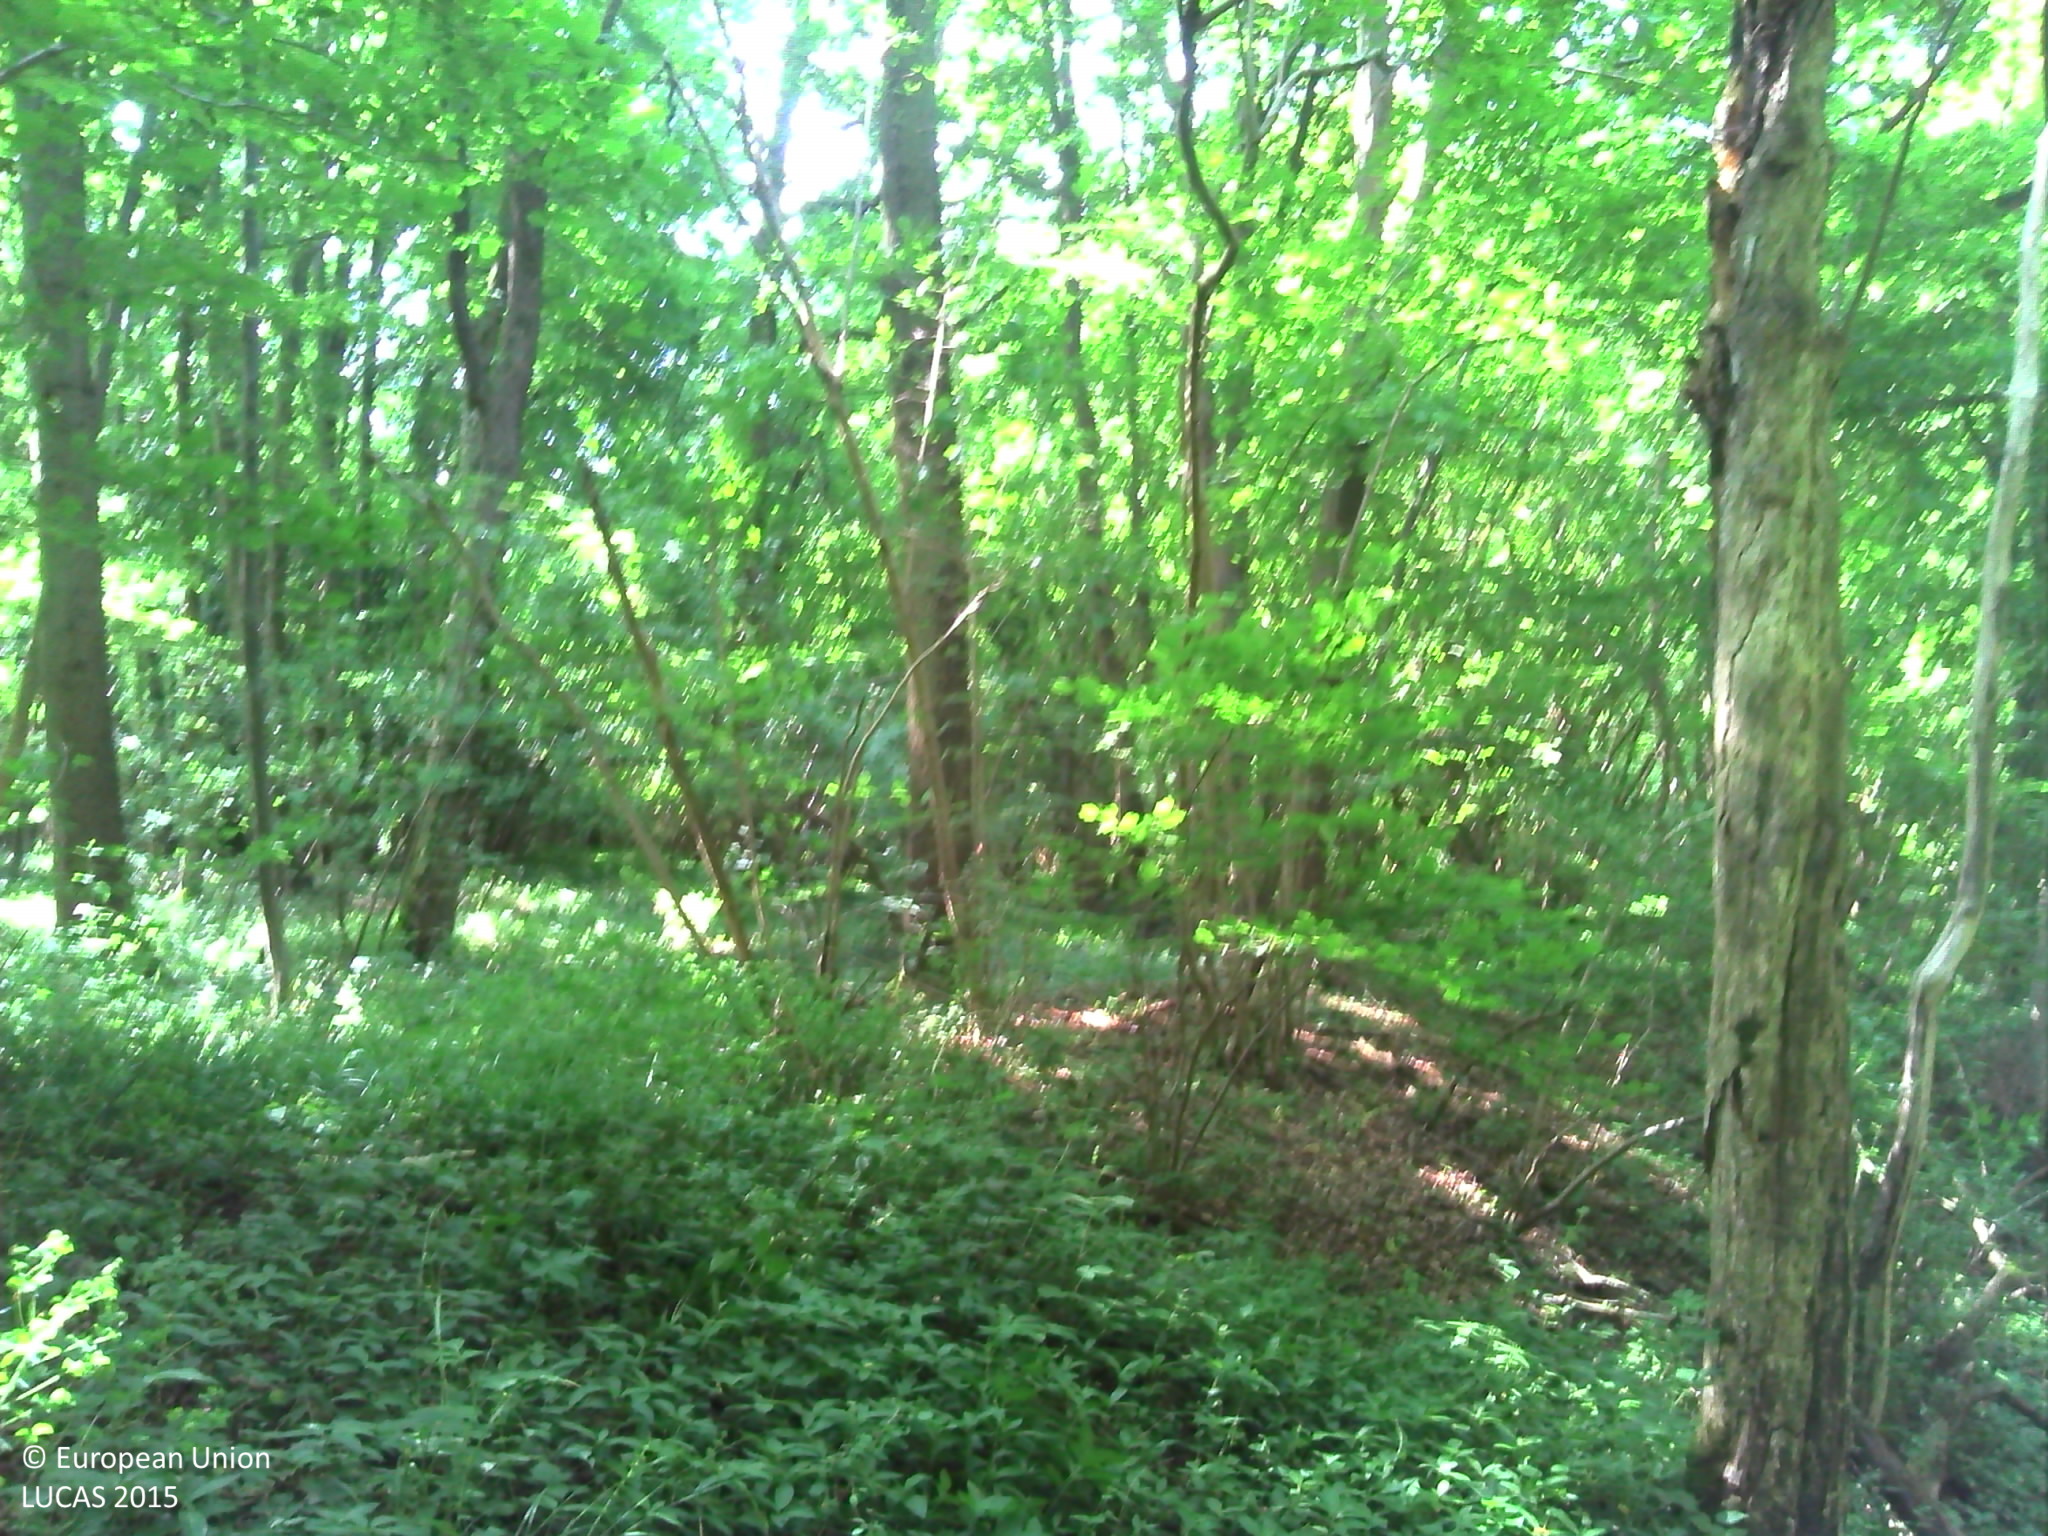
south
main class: Woodland
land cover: Broadleaved woodland
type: mesophytic deciduous forest
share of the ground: > 75 %
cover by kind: broadleaved forest trees 55 %, herbaceous plants 40 %, shrubs 5 %
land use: Forestry
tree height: > 5 m
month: June
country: FR
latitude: 49.5423
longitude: 2.5392
